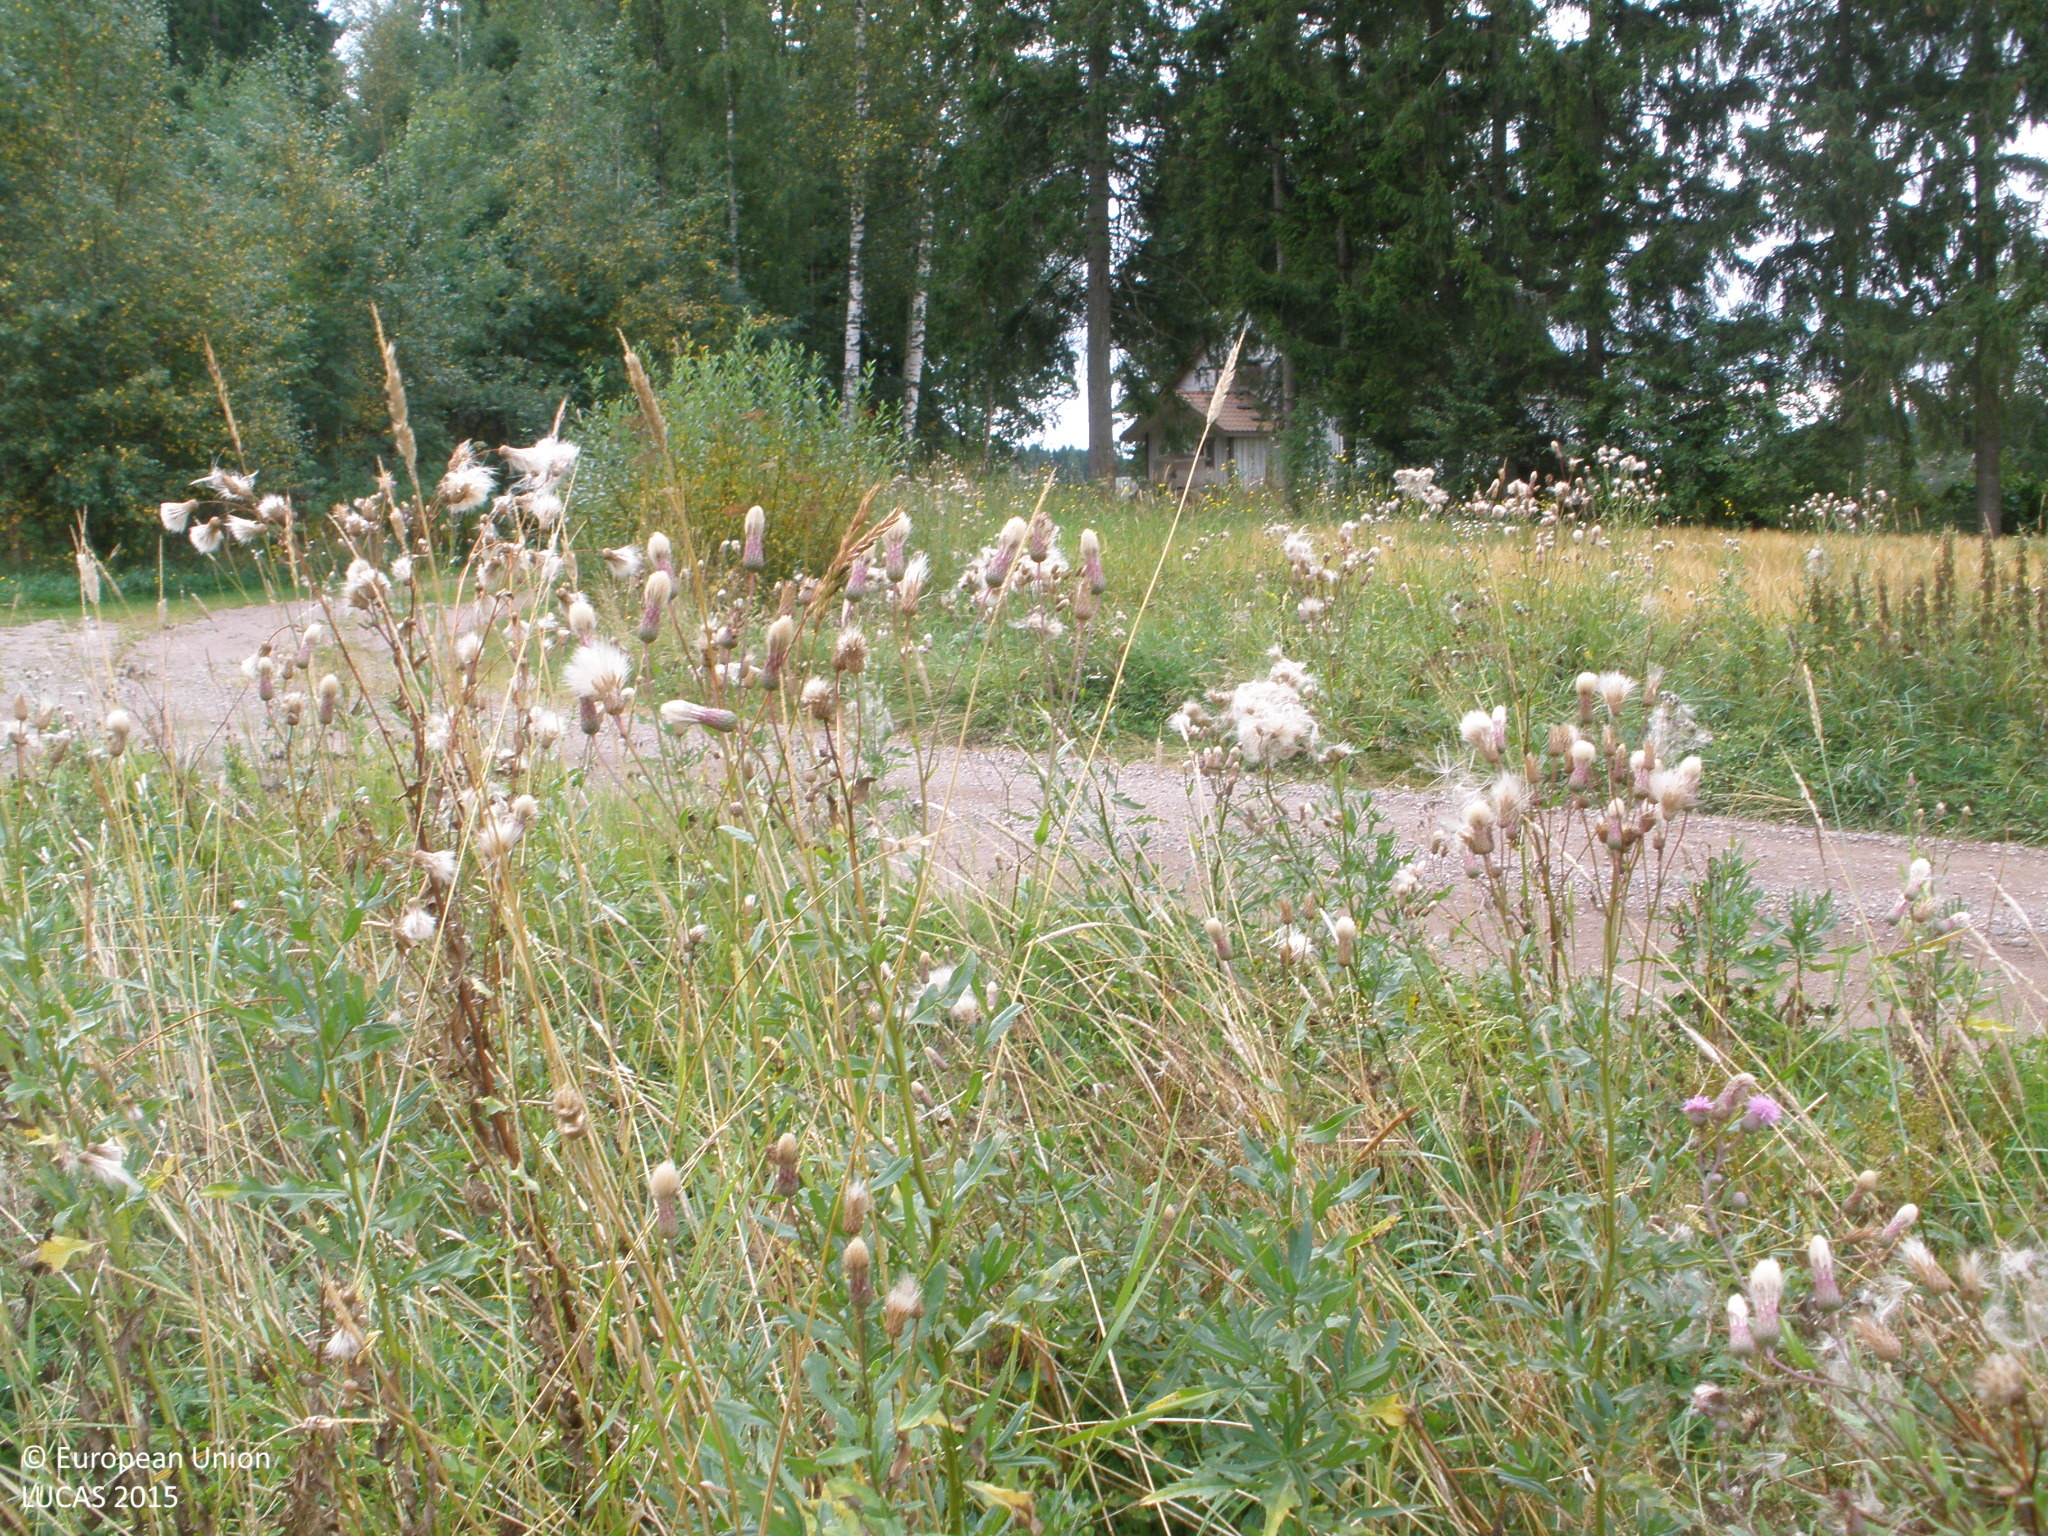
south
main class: Cropland
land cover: Barley
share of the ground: > 75 %
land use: Agriculture (excluding fallow land and kitchen gardens)
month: August
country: FI
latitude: 60.5822
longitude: 23.5755
